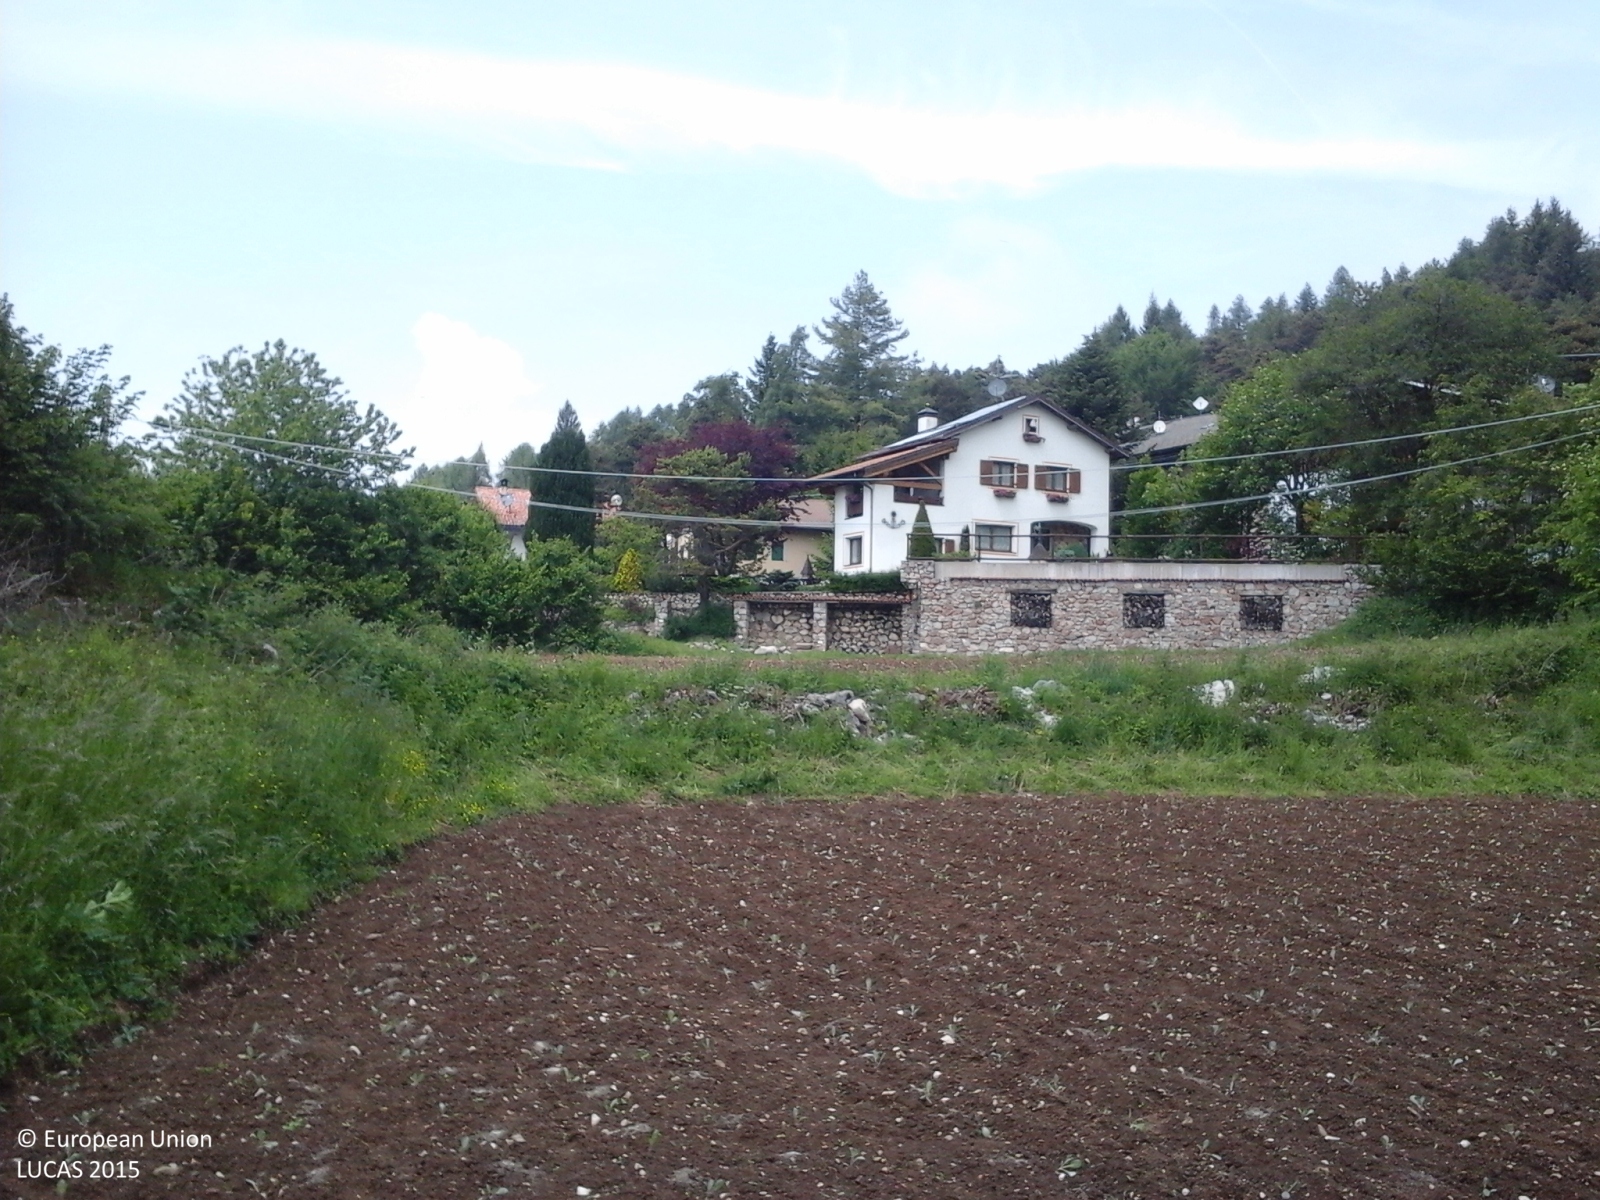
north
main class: Cropland
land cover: Other fresh vegetables
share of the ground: < 10 %
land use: Agriculture (excluding fallow land and kitchen gardens)
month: June
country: IT
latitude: 45.8967
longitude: 10.9394
